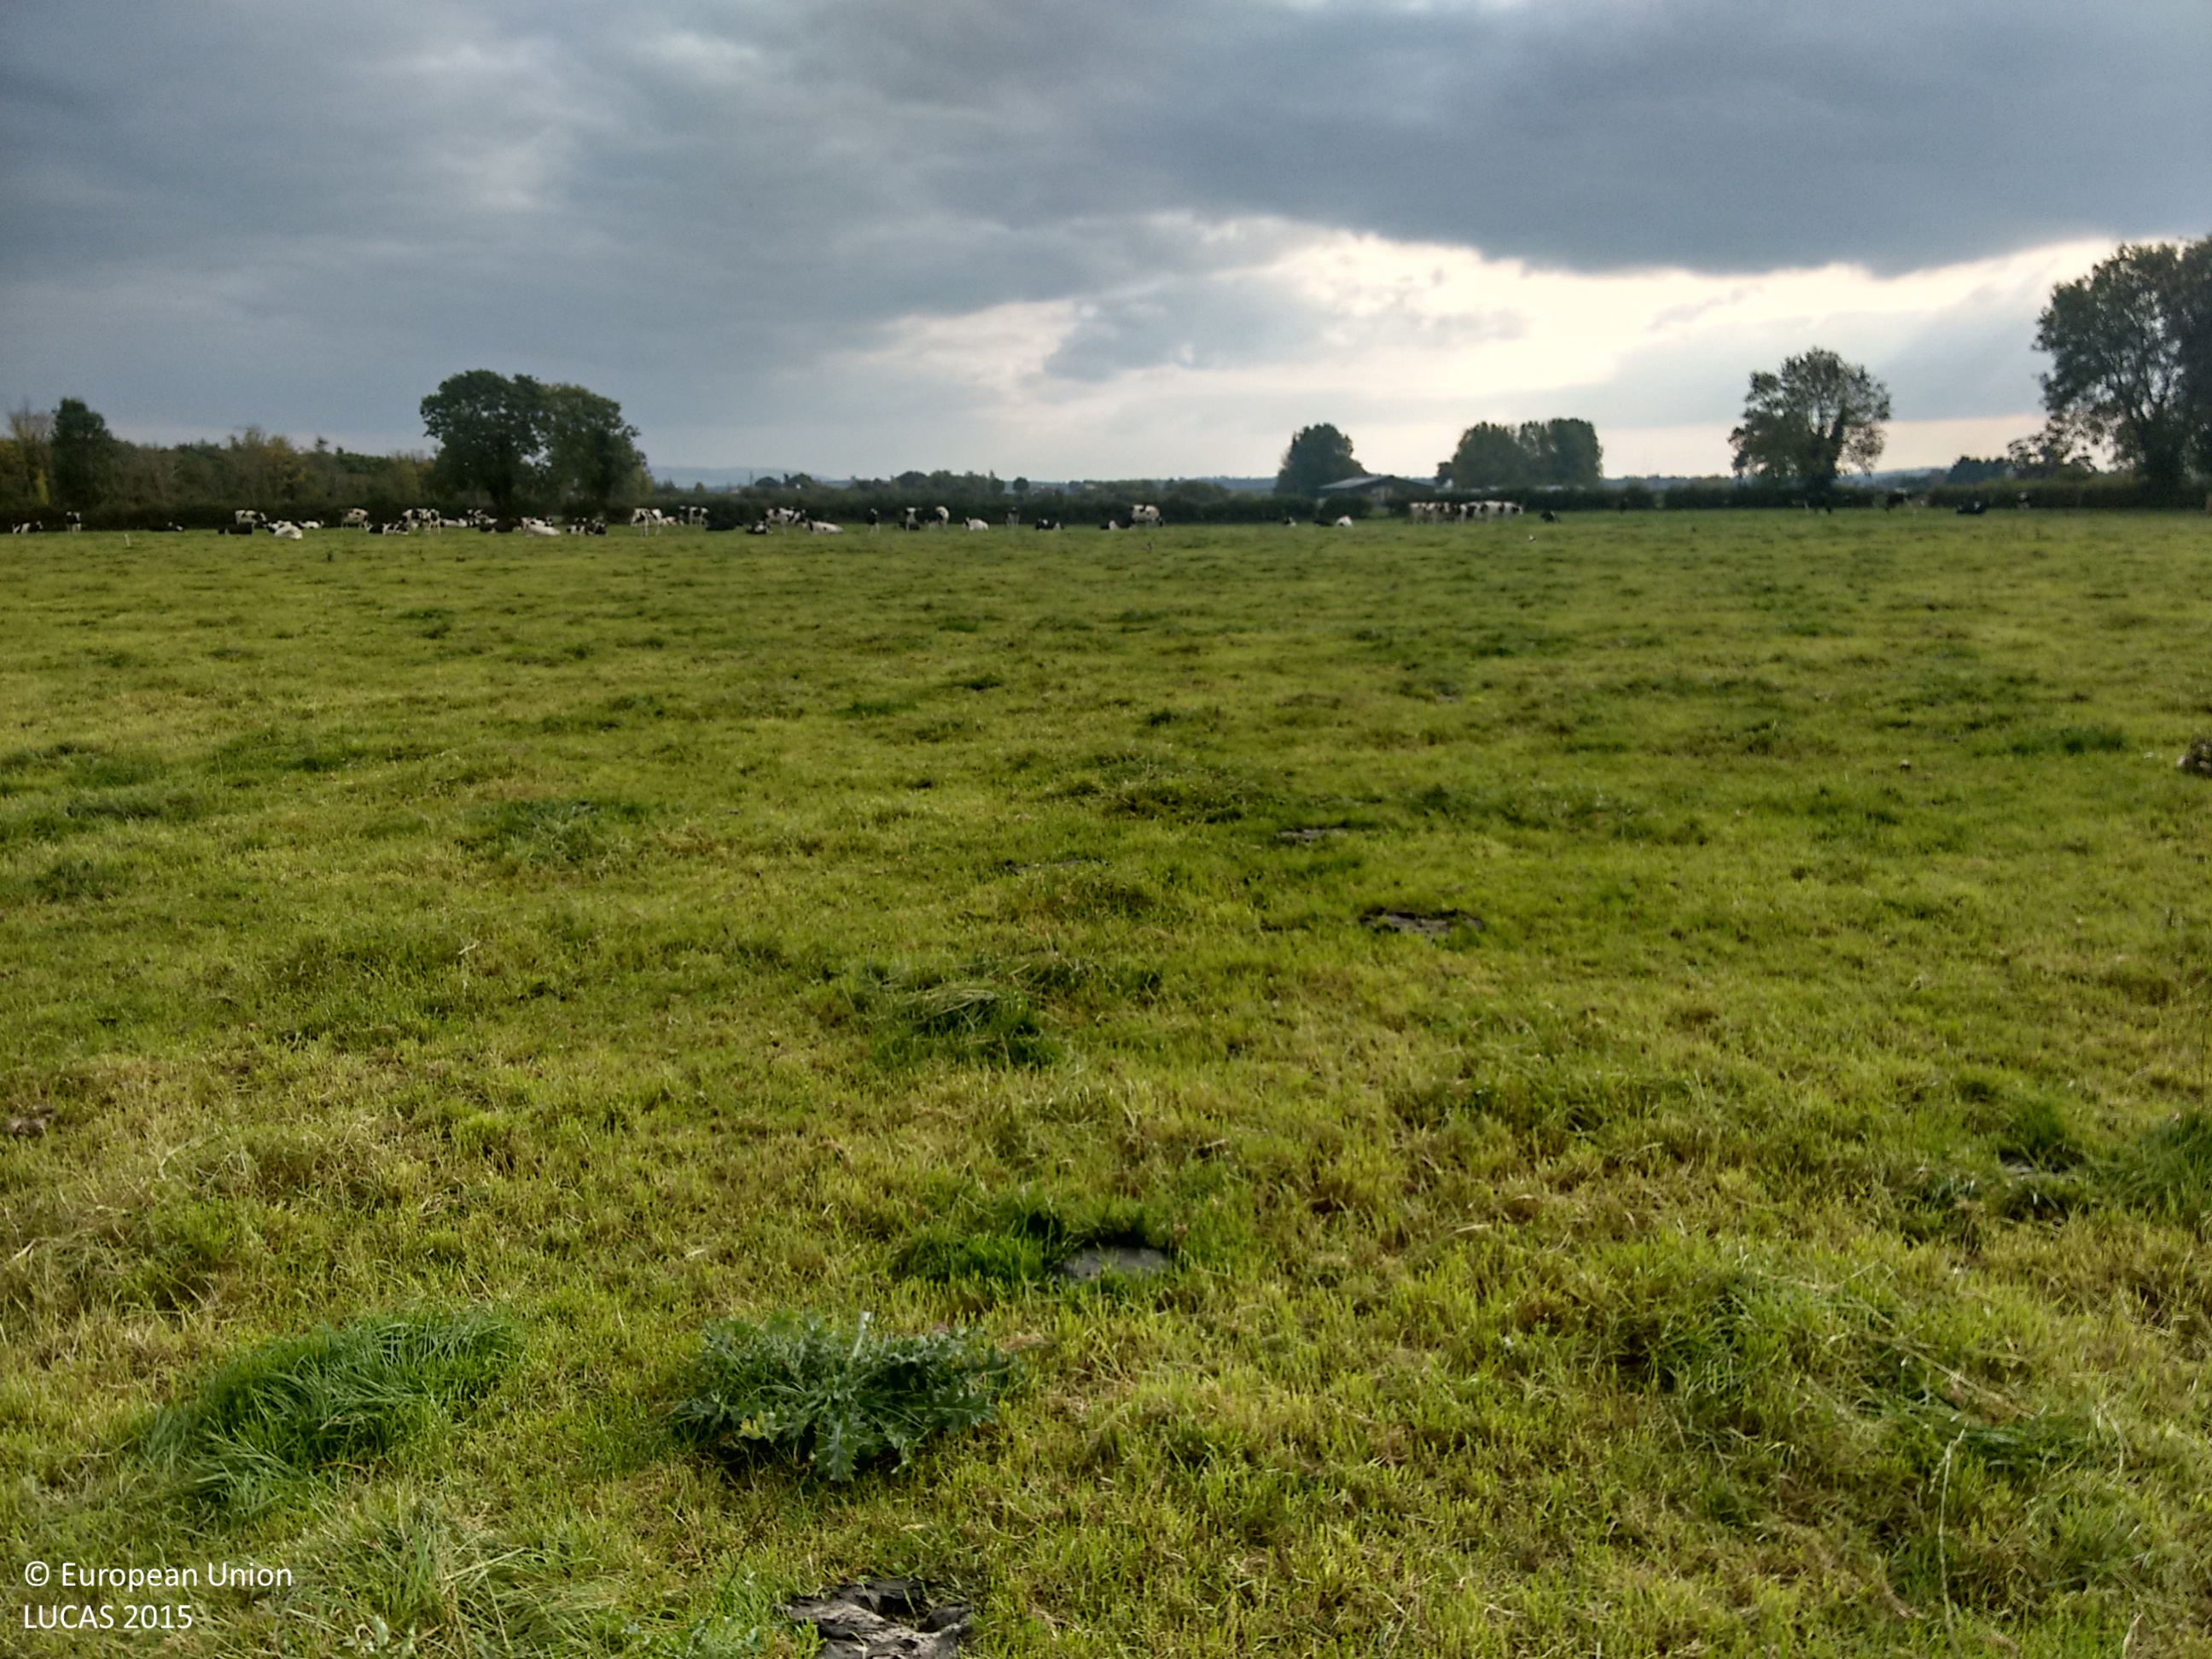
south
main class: Grassland
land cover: Grassland without tree/shrub cover
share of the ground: > 75 %
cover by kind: herbaceous plants 95 %, shrubs 5 %
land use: Agriculture (excluding fallow land and kitchen gardens)
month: October
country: IE
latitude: 52.8776
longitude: -7.5601
